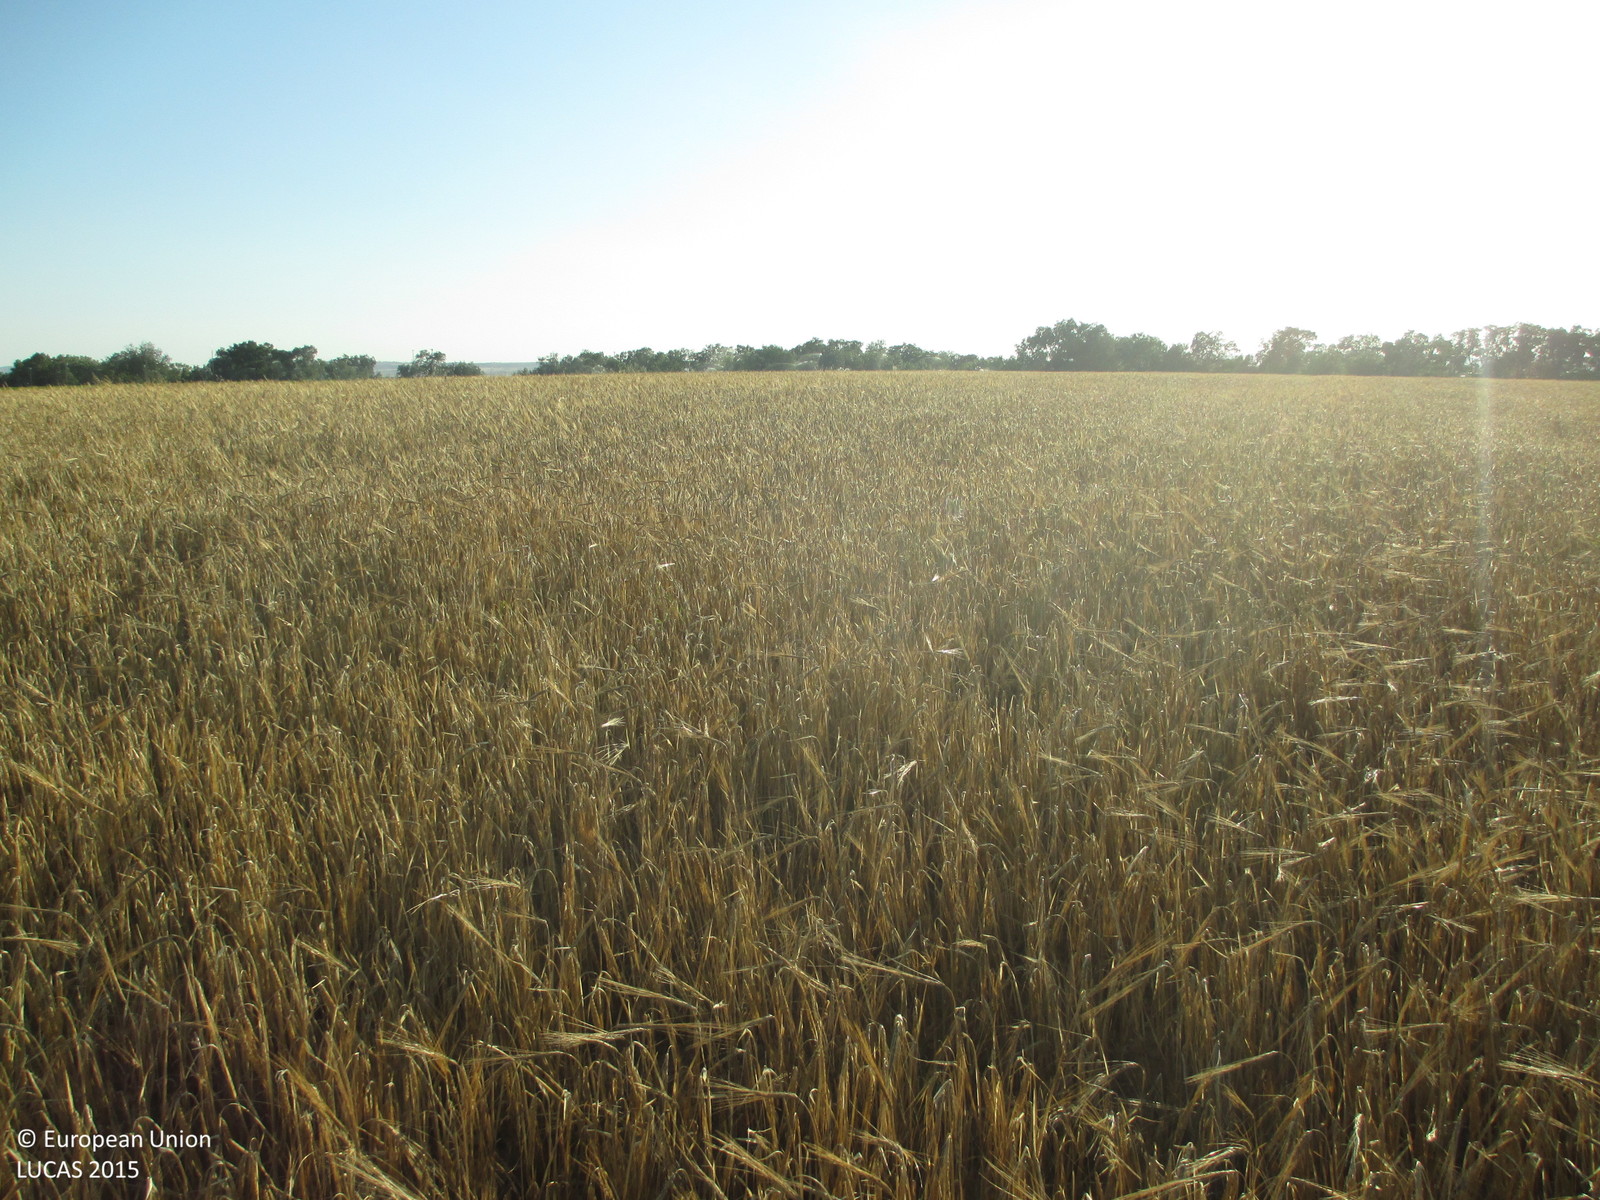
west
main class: Cropland
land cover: Barley
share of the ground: > 75 %
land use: Agriculture (excluding fallow land and kitchen gardens)
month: June
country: ES
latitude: 42.0445
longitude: -0.3995
